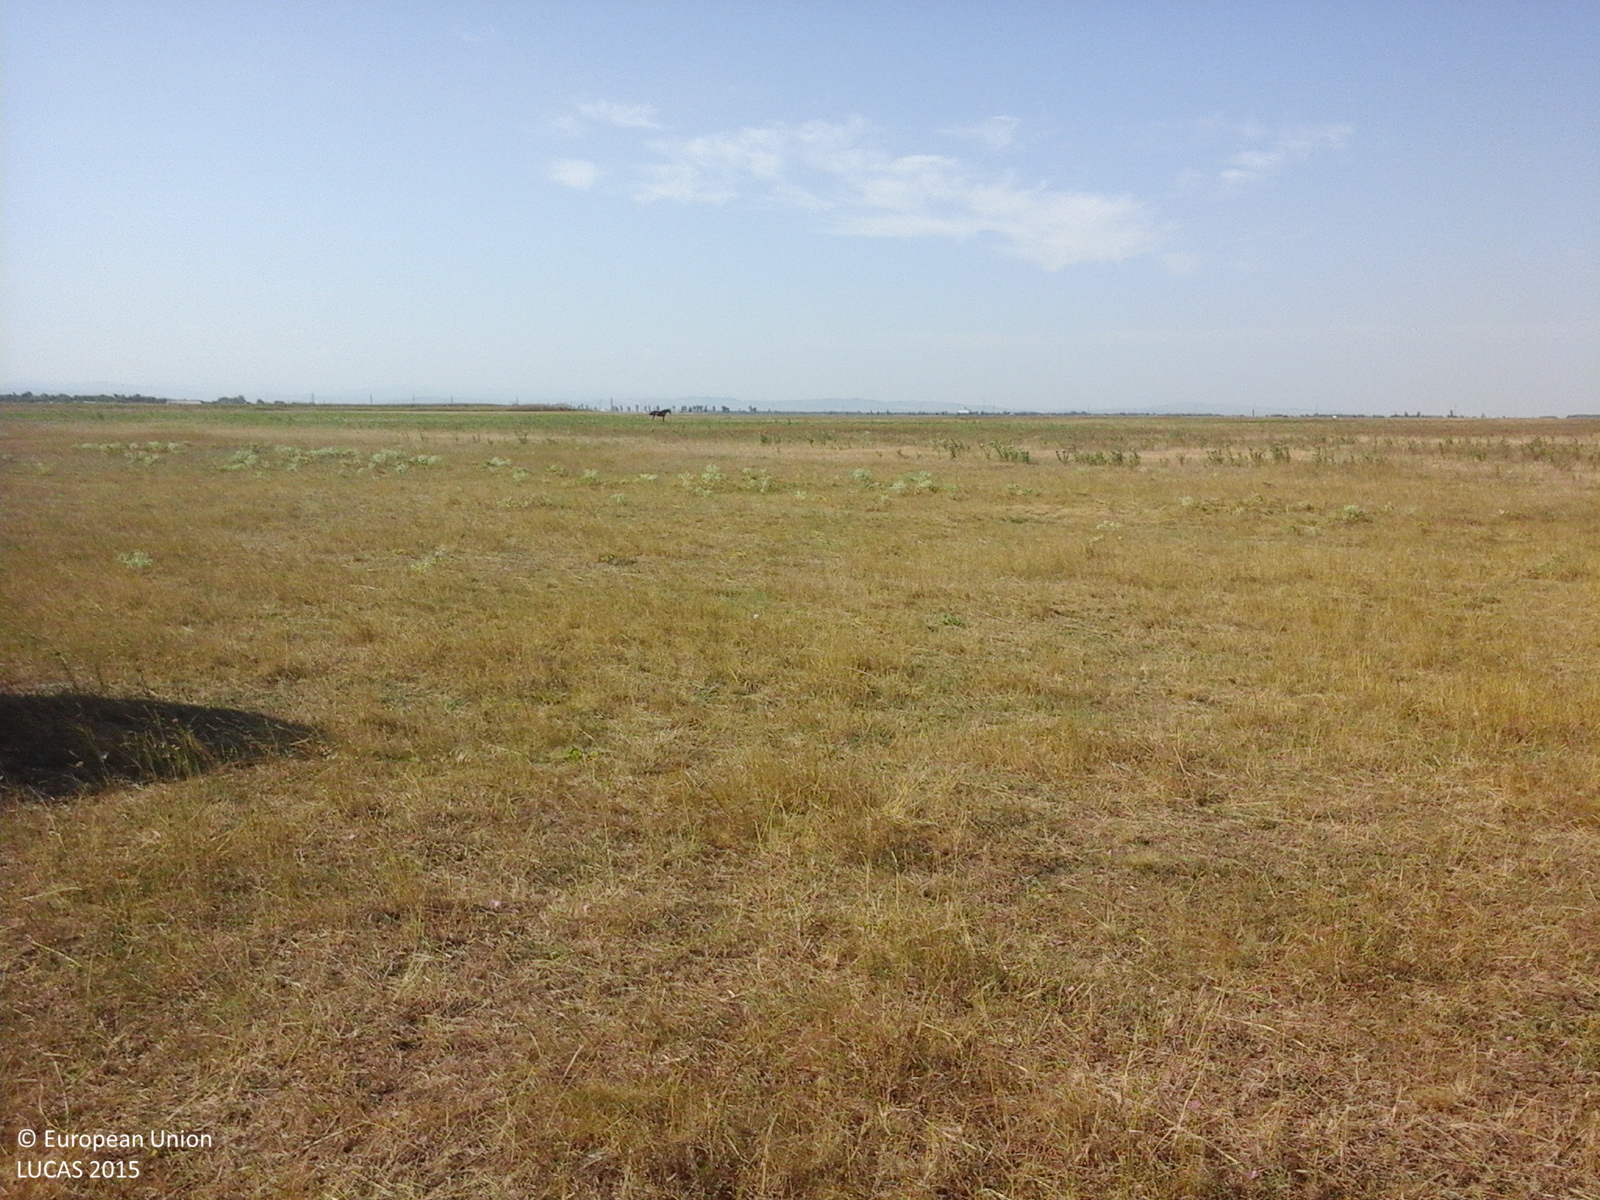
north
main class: Grassland
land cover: Grassland without tree/shrub cover
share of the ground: > 75 %
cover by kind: herbaceous plants 100 %
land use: Agriculture (excluding fallow land and kitchen gardens)
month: August
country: RO
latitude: 45.0349
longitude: 26.8739
